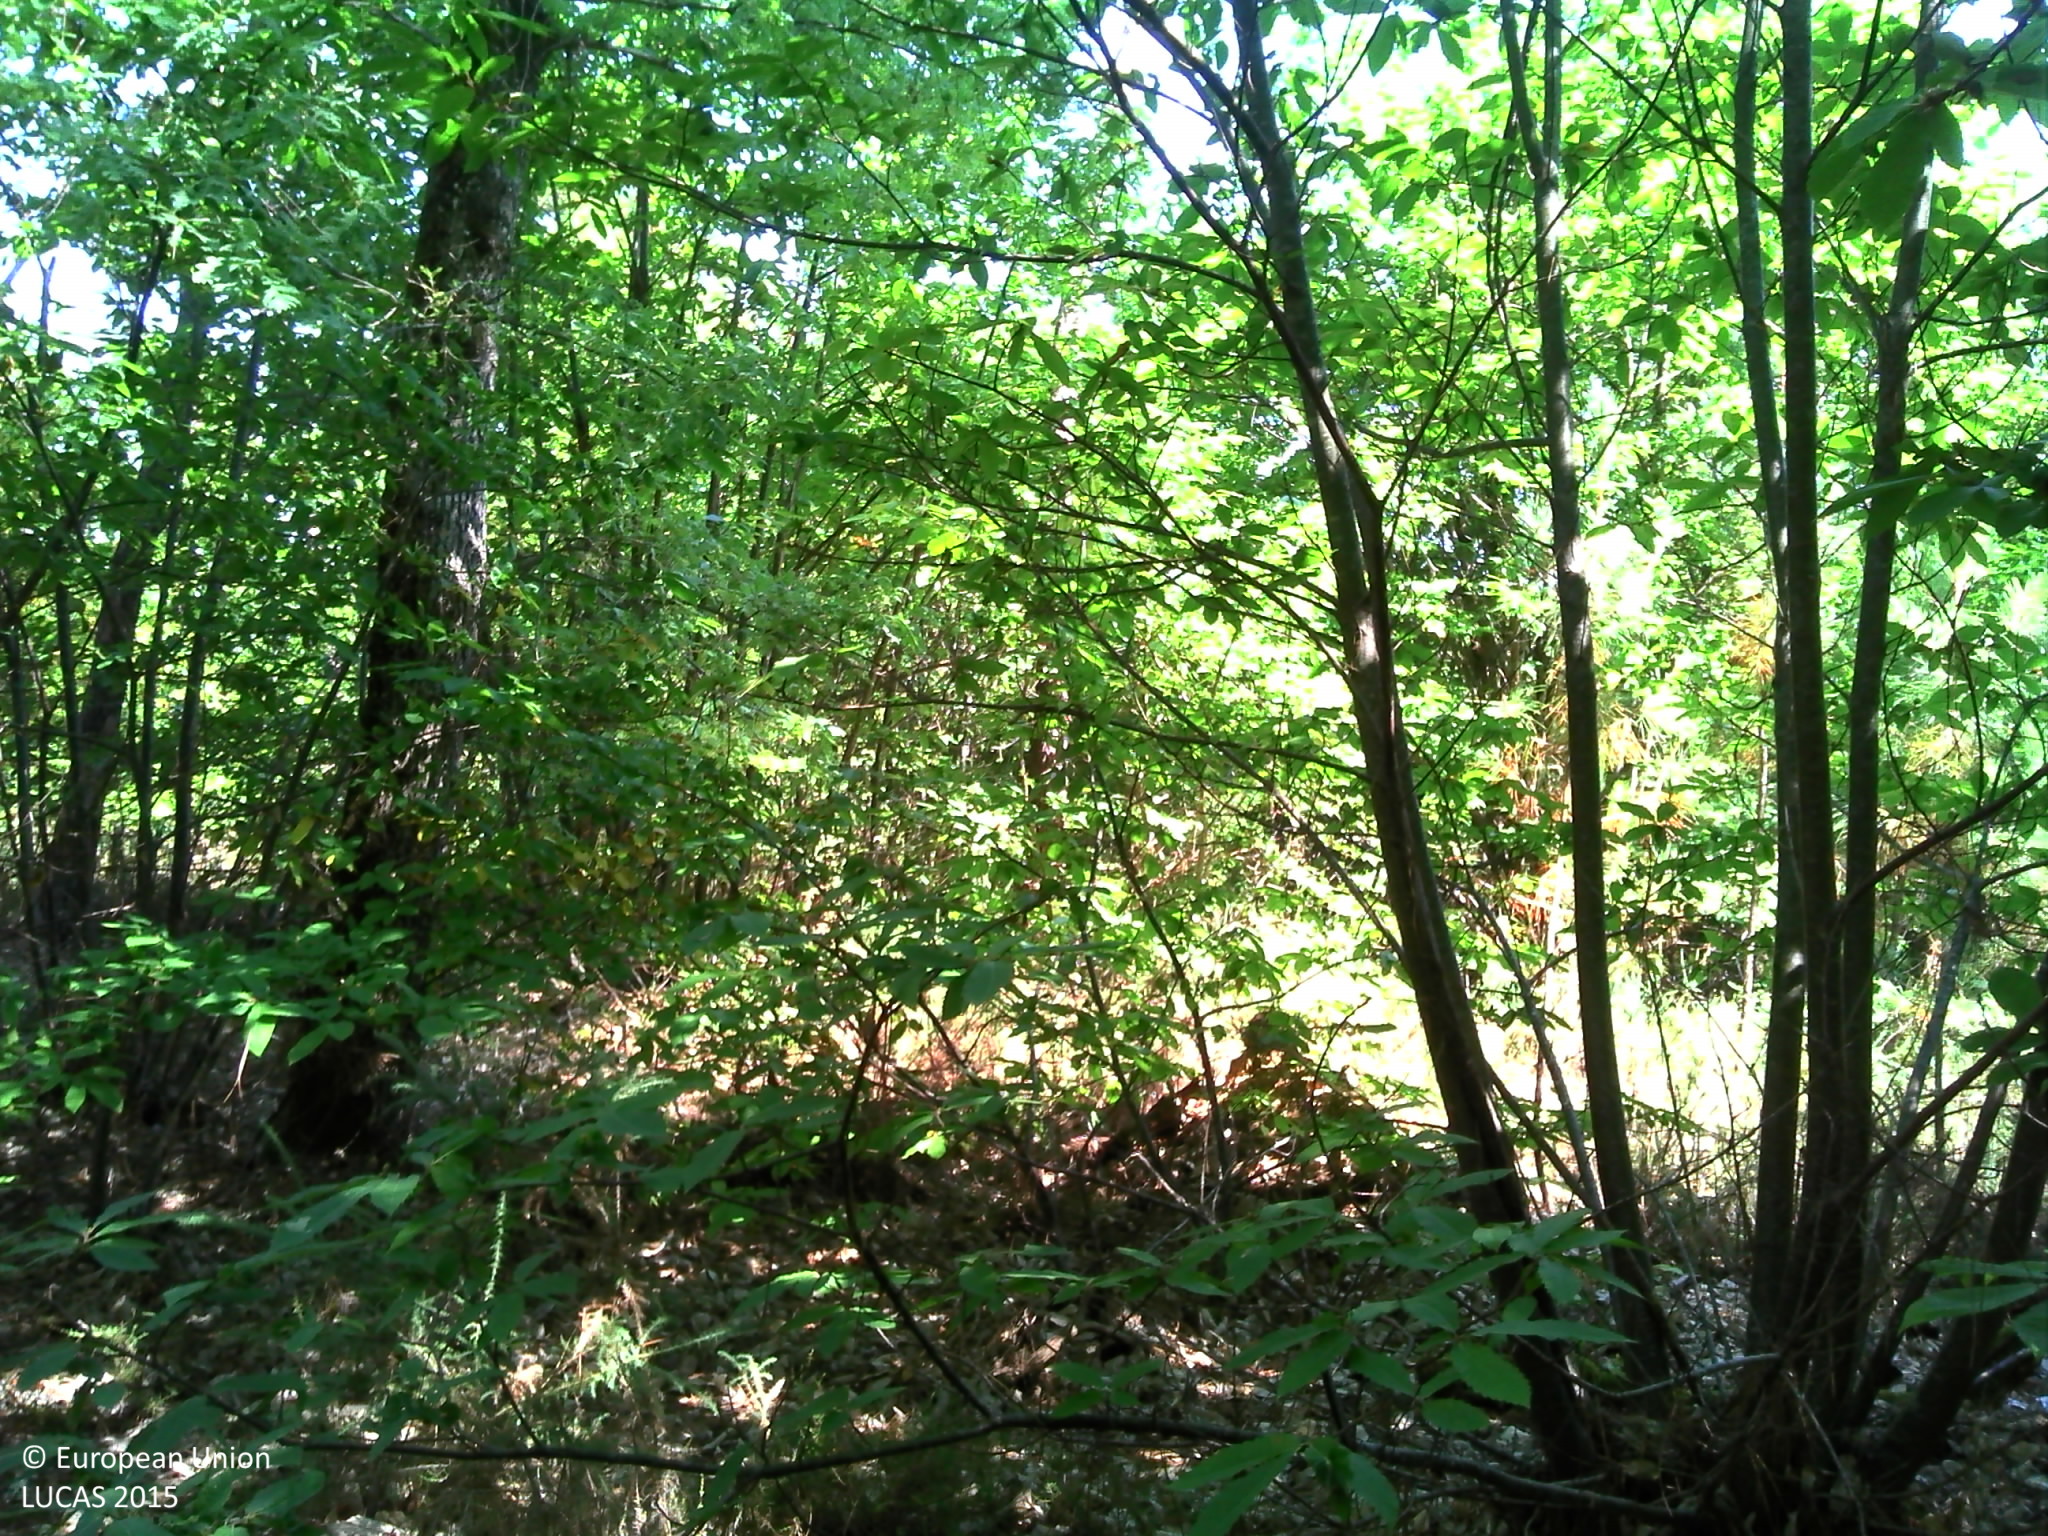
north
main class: Woodland
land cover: Broadleaved woodland
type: thermophilous deciduous forest
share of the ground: > 75 %
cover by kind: broadleaved forest trees 40 %, unconsolidated bare surface 20 %, coniferous forest trees 10 %, shrubs 10 %, herbaceous plants 10 %, lichens and mosses 10 %
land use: Forestry
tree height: > 5 m
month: July
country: FR
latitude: 45.0729
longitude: 0.4752
